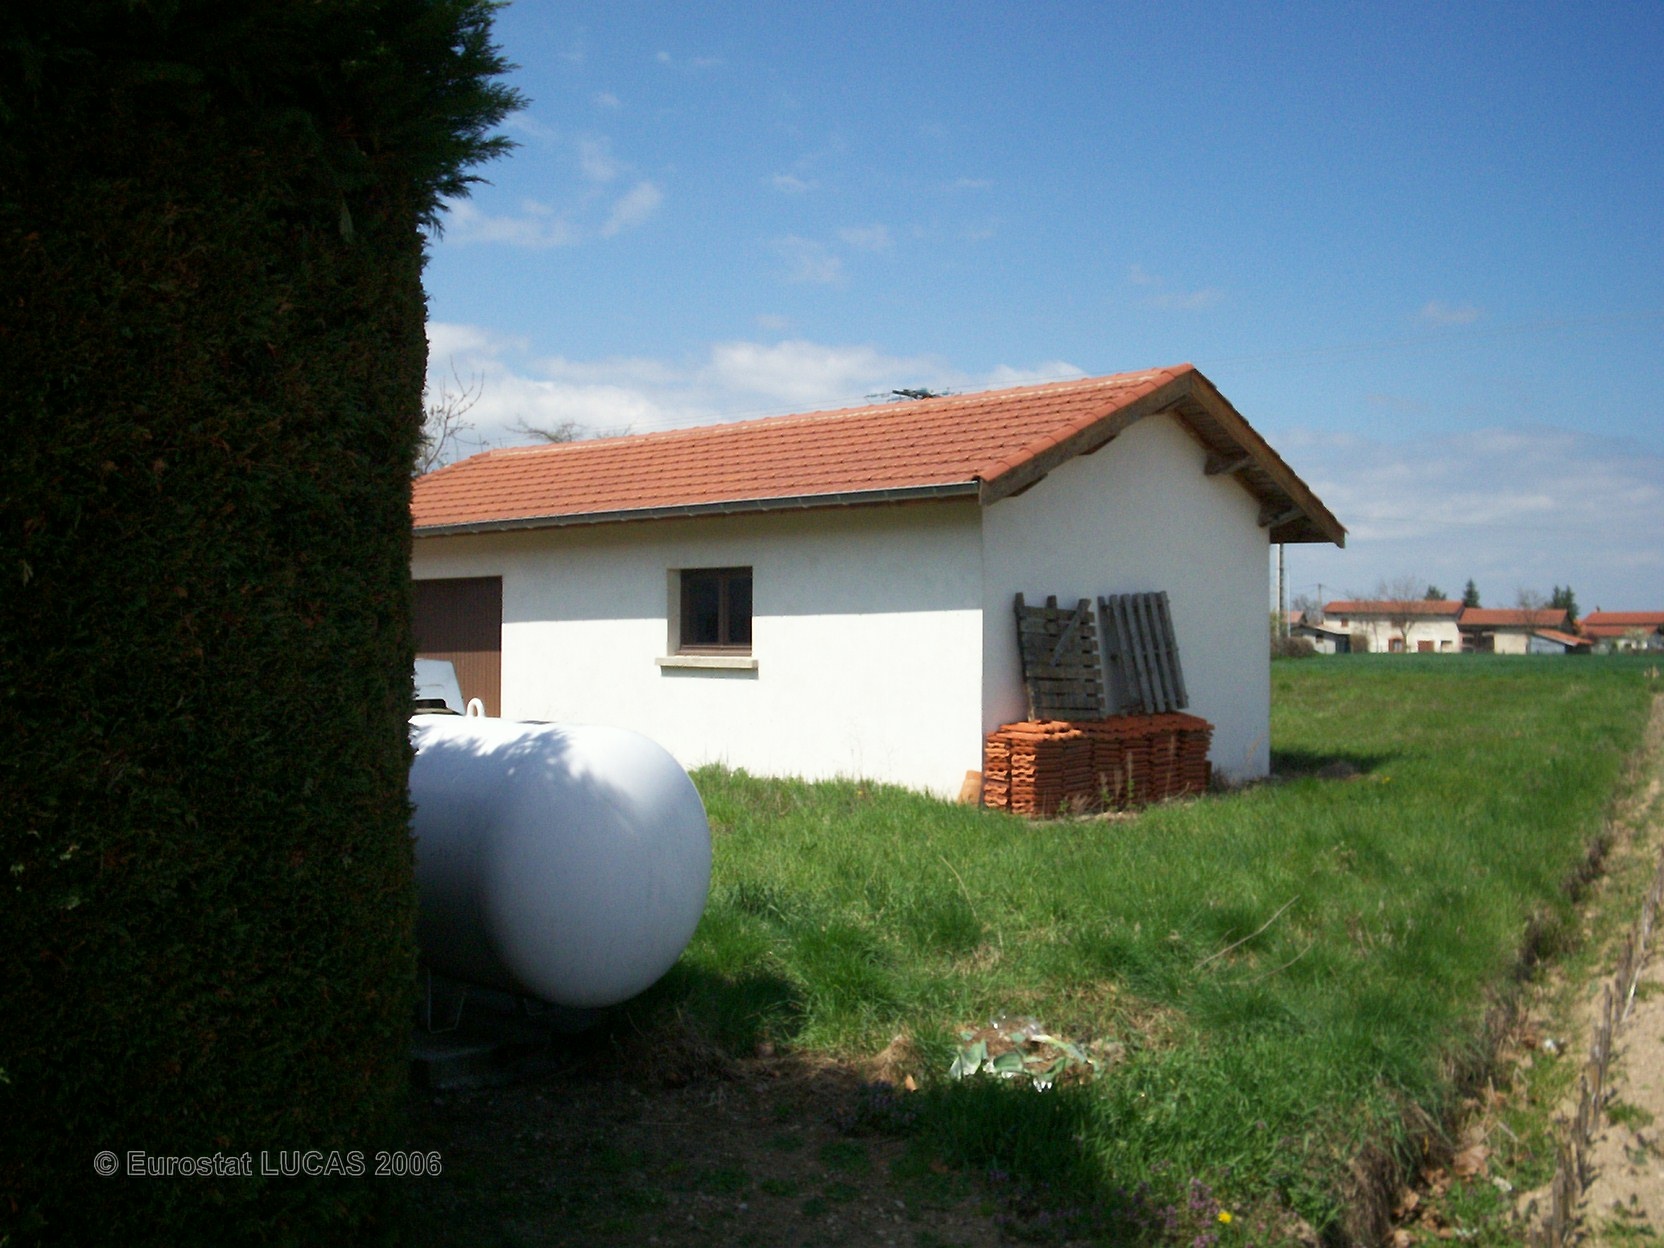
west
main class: Bare land
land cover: Bare land
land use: Fallow land
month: April
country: FR
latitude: 45.7385
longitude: 4.1292
